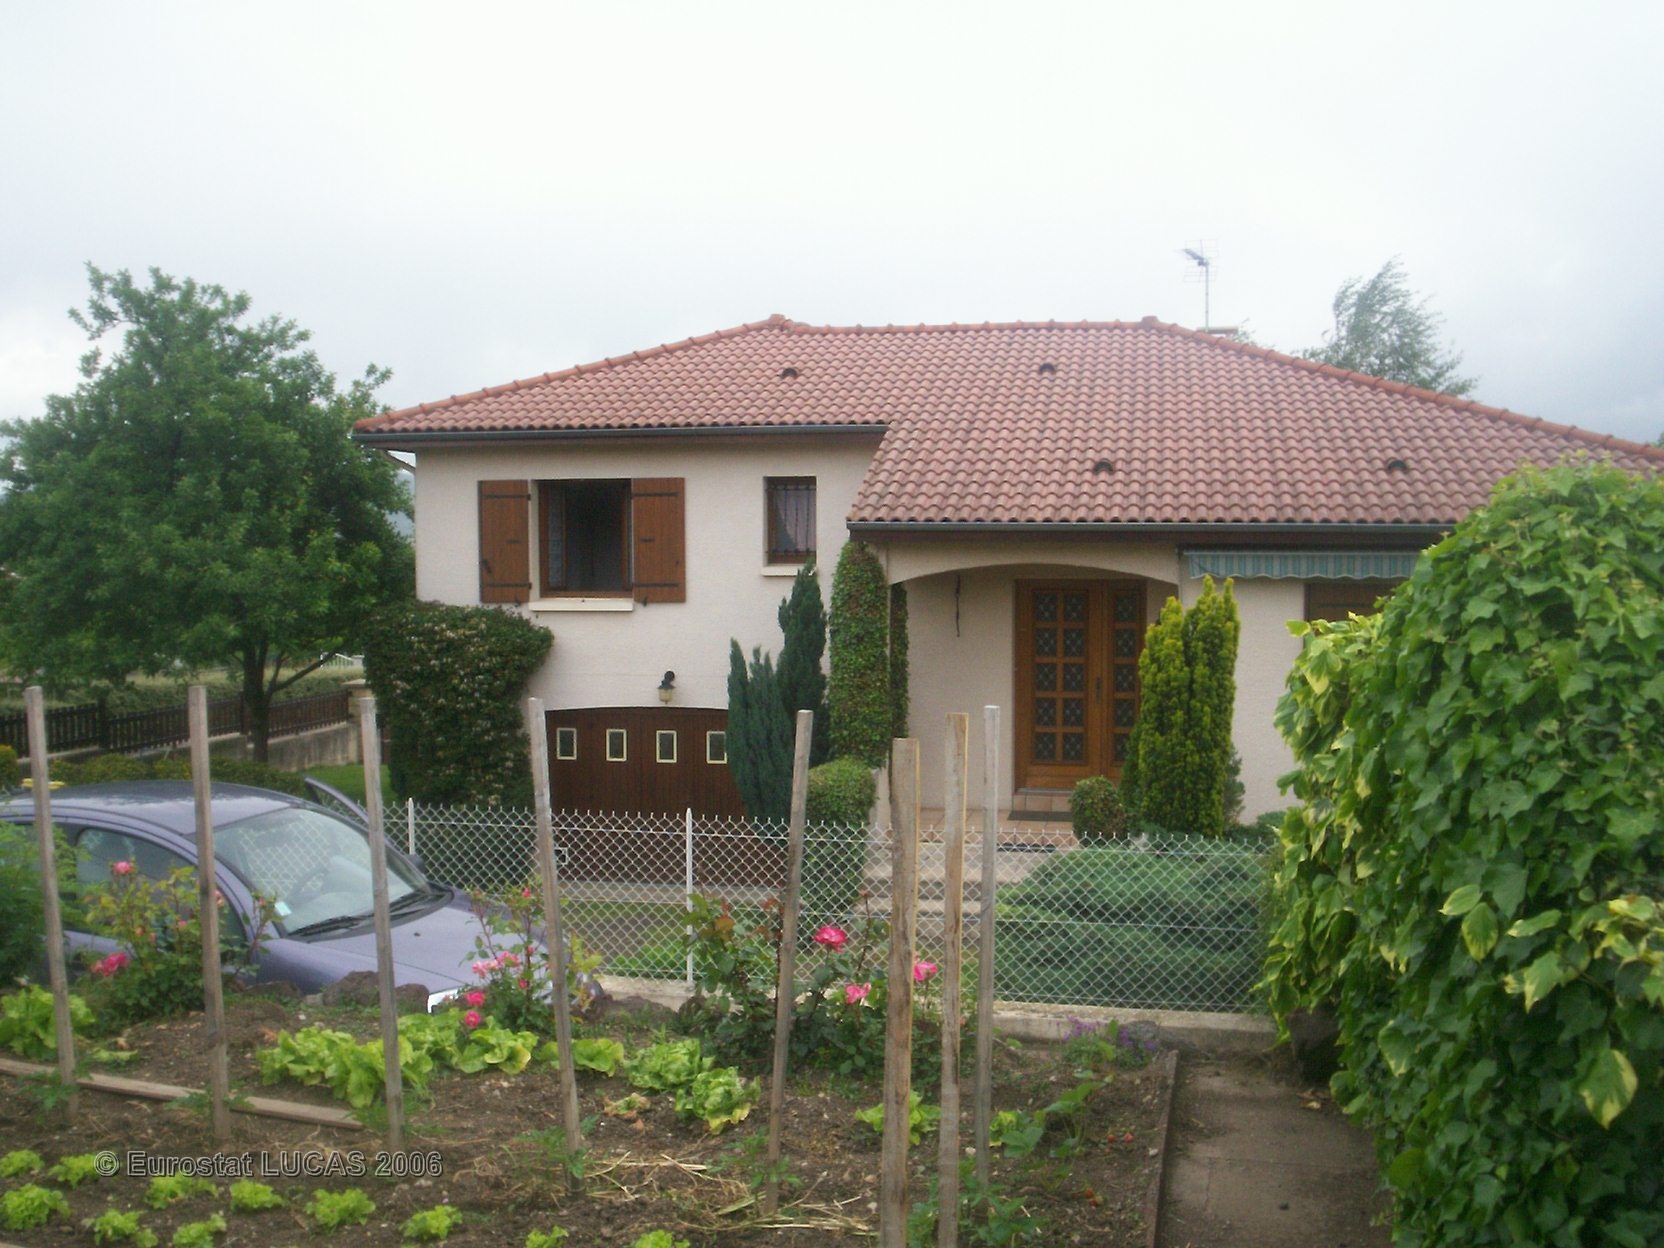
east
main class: Cropland
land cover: Other fresh vegetables
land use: Kitchen garden
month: May
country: FR
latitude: 45.7372
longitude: 3.2016
